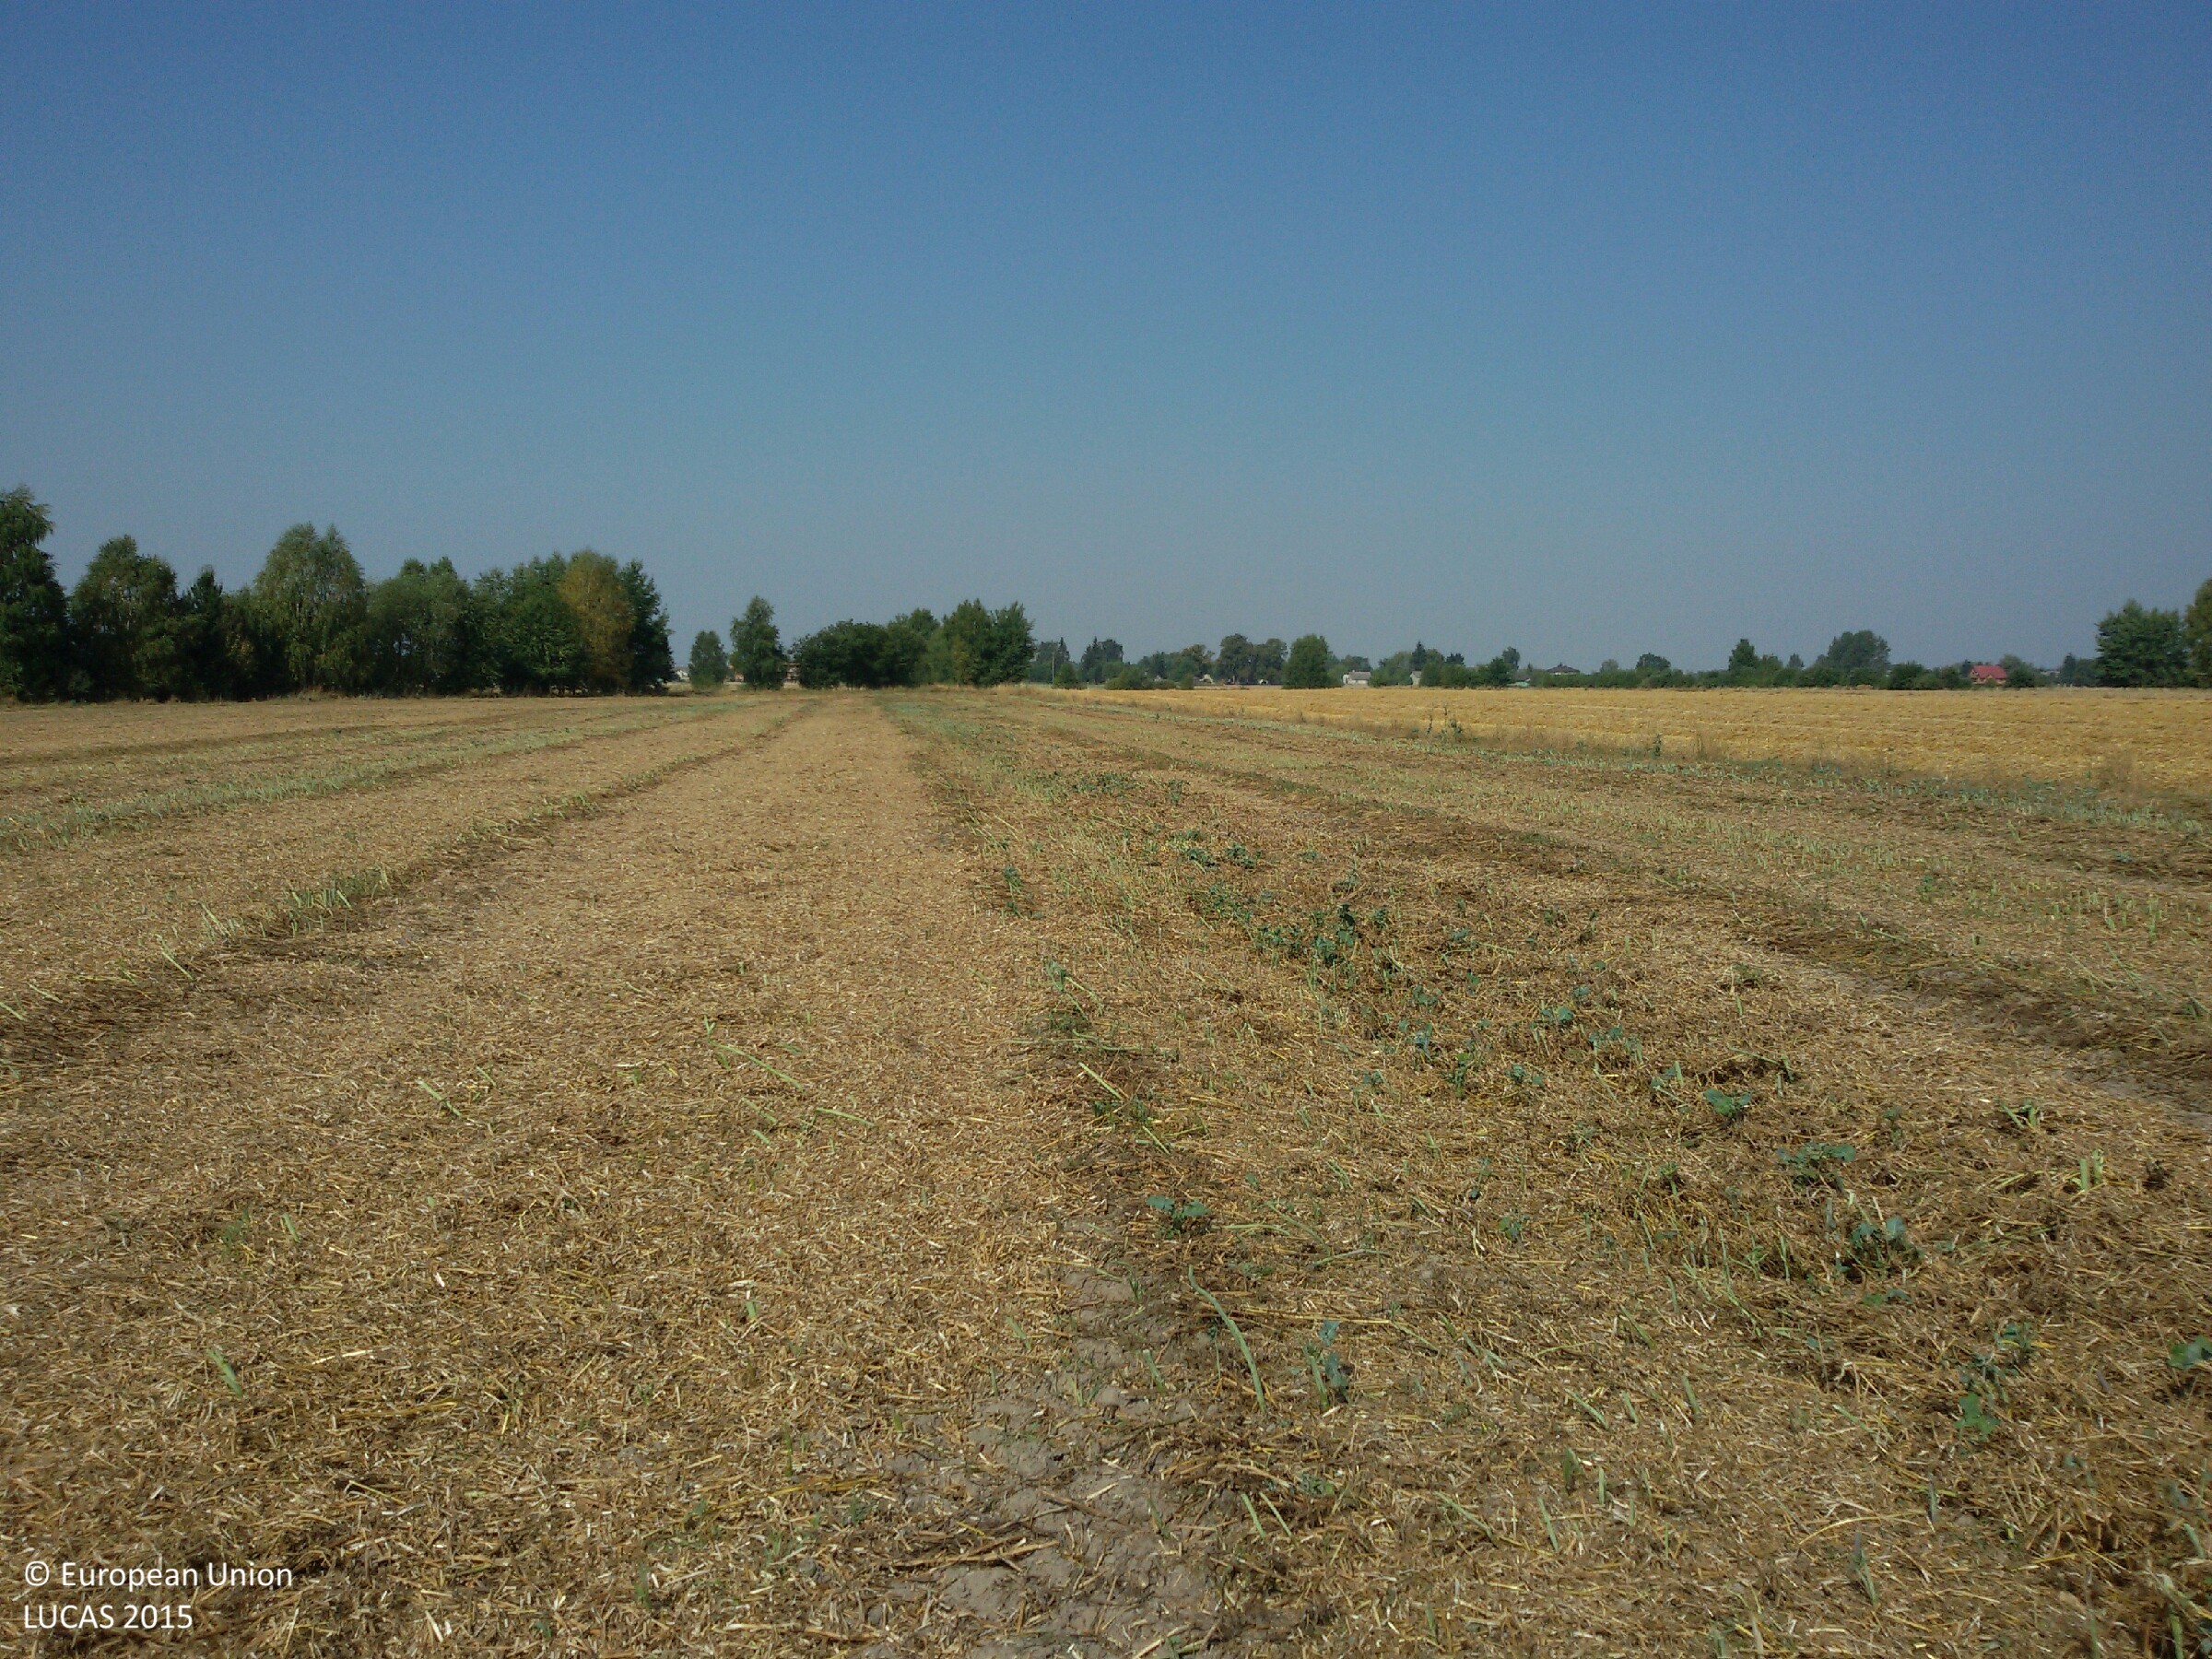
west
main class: Cropland
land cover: Barley
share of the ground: 50 - 75 %
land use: Agriculture (excluding fallow land and kitchen gardens)
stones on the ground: < 10 %
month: August
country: PL
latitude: 51.6763
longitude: 22.8418
